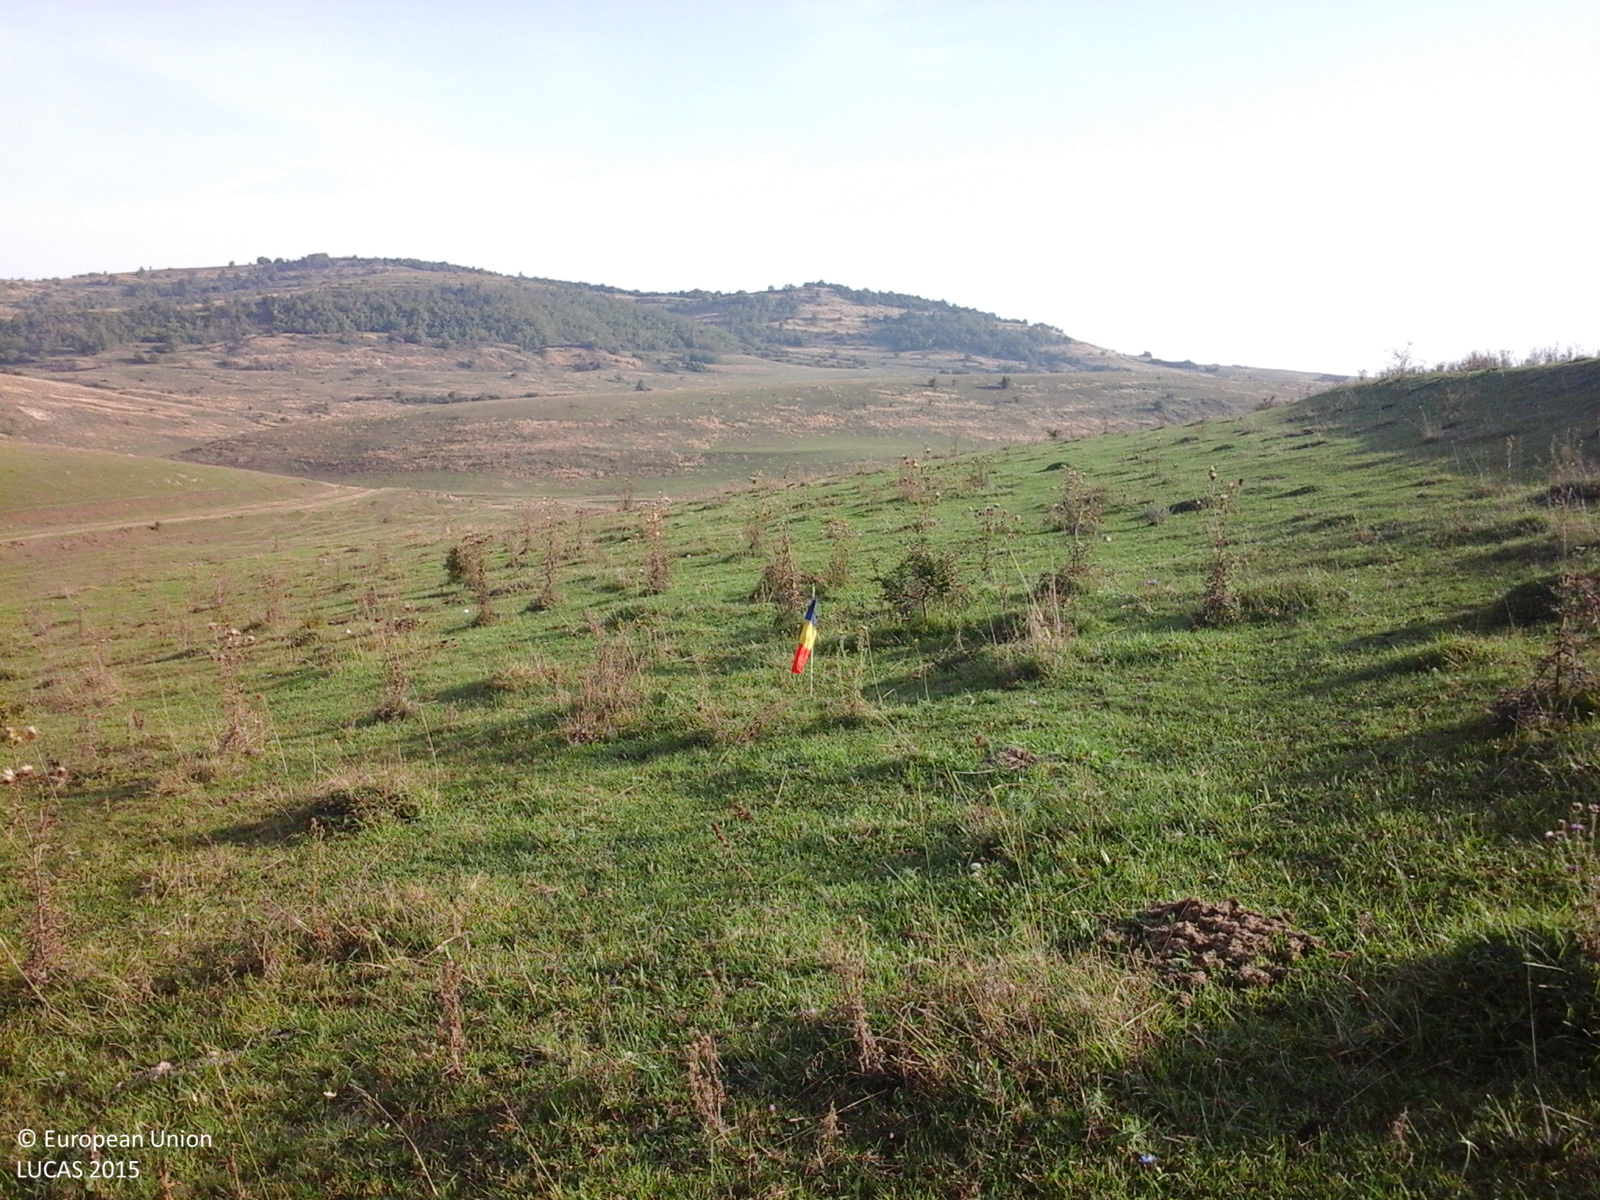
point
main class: Grassland
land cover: Grassland without tree/shrub cover
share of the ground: > 75 %
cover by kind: herbaceous plants 100 %
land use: Agriculture (excluding fallow land and kitchen gardens)
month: September
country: RO
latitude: 46.8384
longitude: 23.3761
